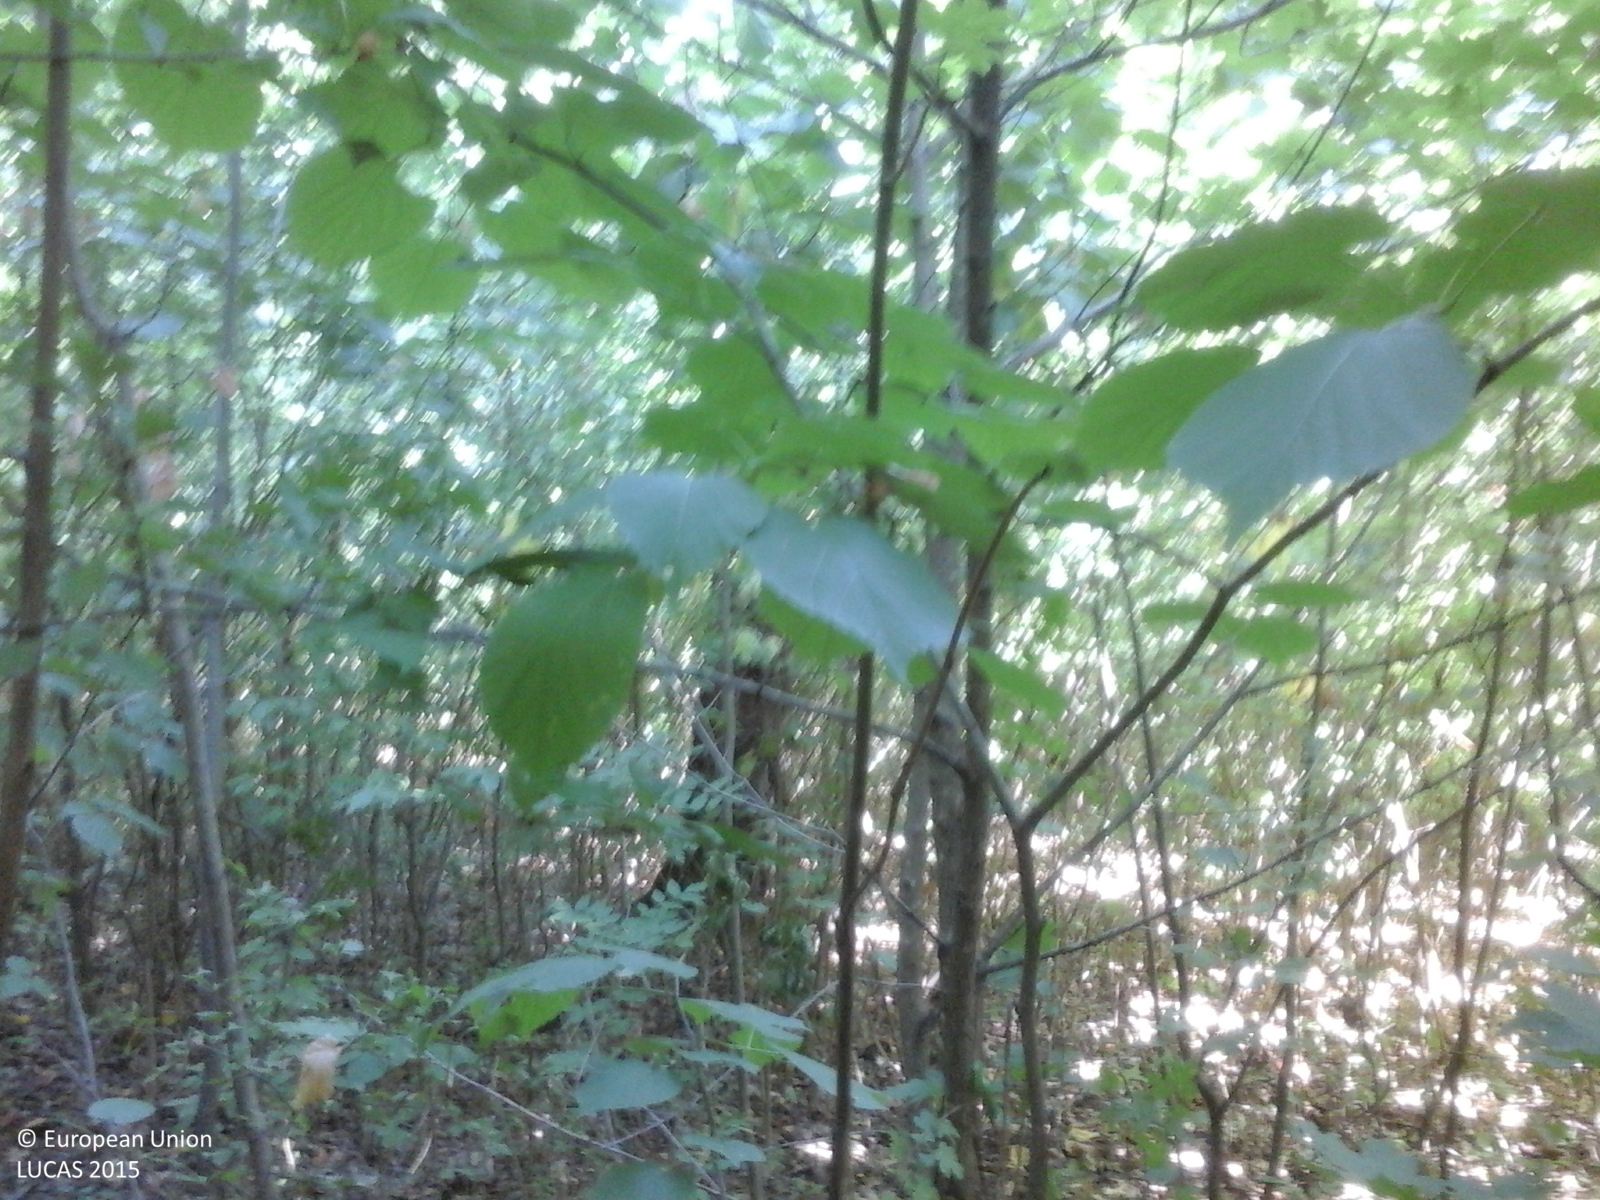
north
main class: Woodland
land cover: Broadleaved woodland
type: thermophilous deciduous forest
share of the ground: > 75 %
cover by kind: broadleaved forest trees 100 %
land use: Forestry
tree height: > 5 m
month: June
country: RO
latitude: 47.0862
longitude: 27.3805
